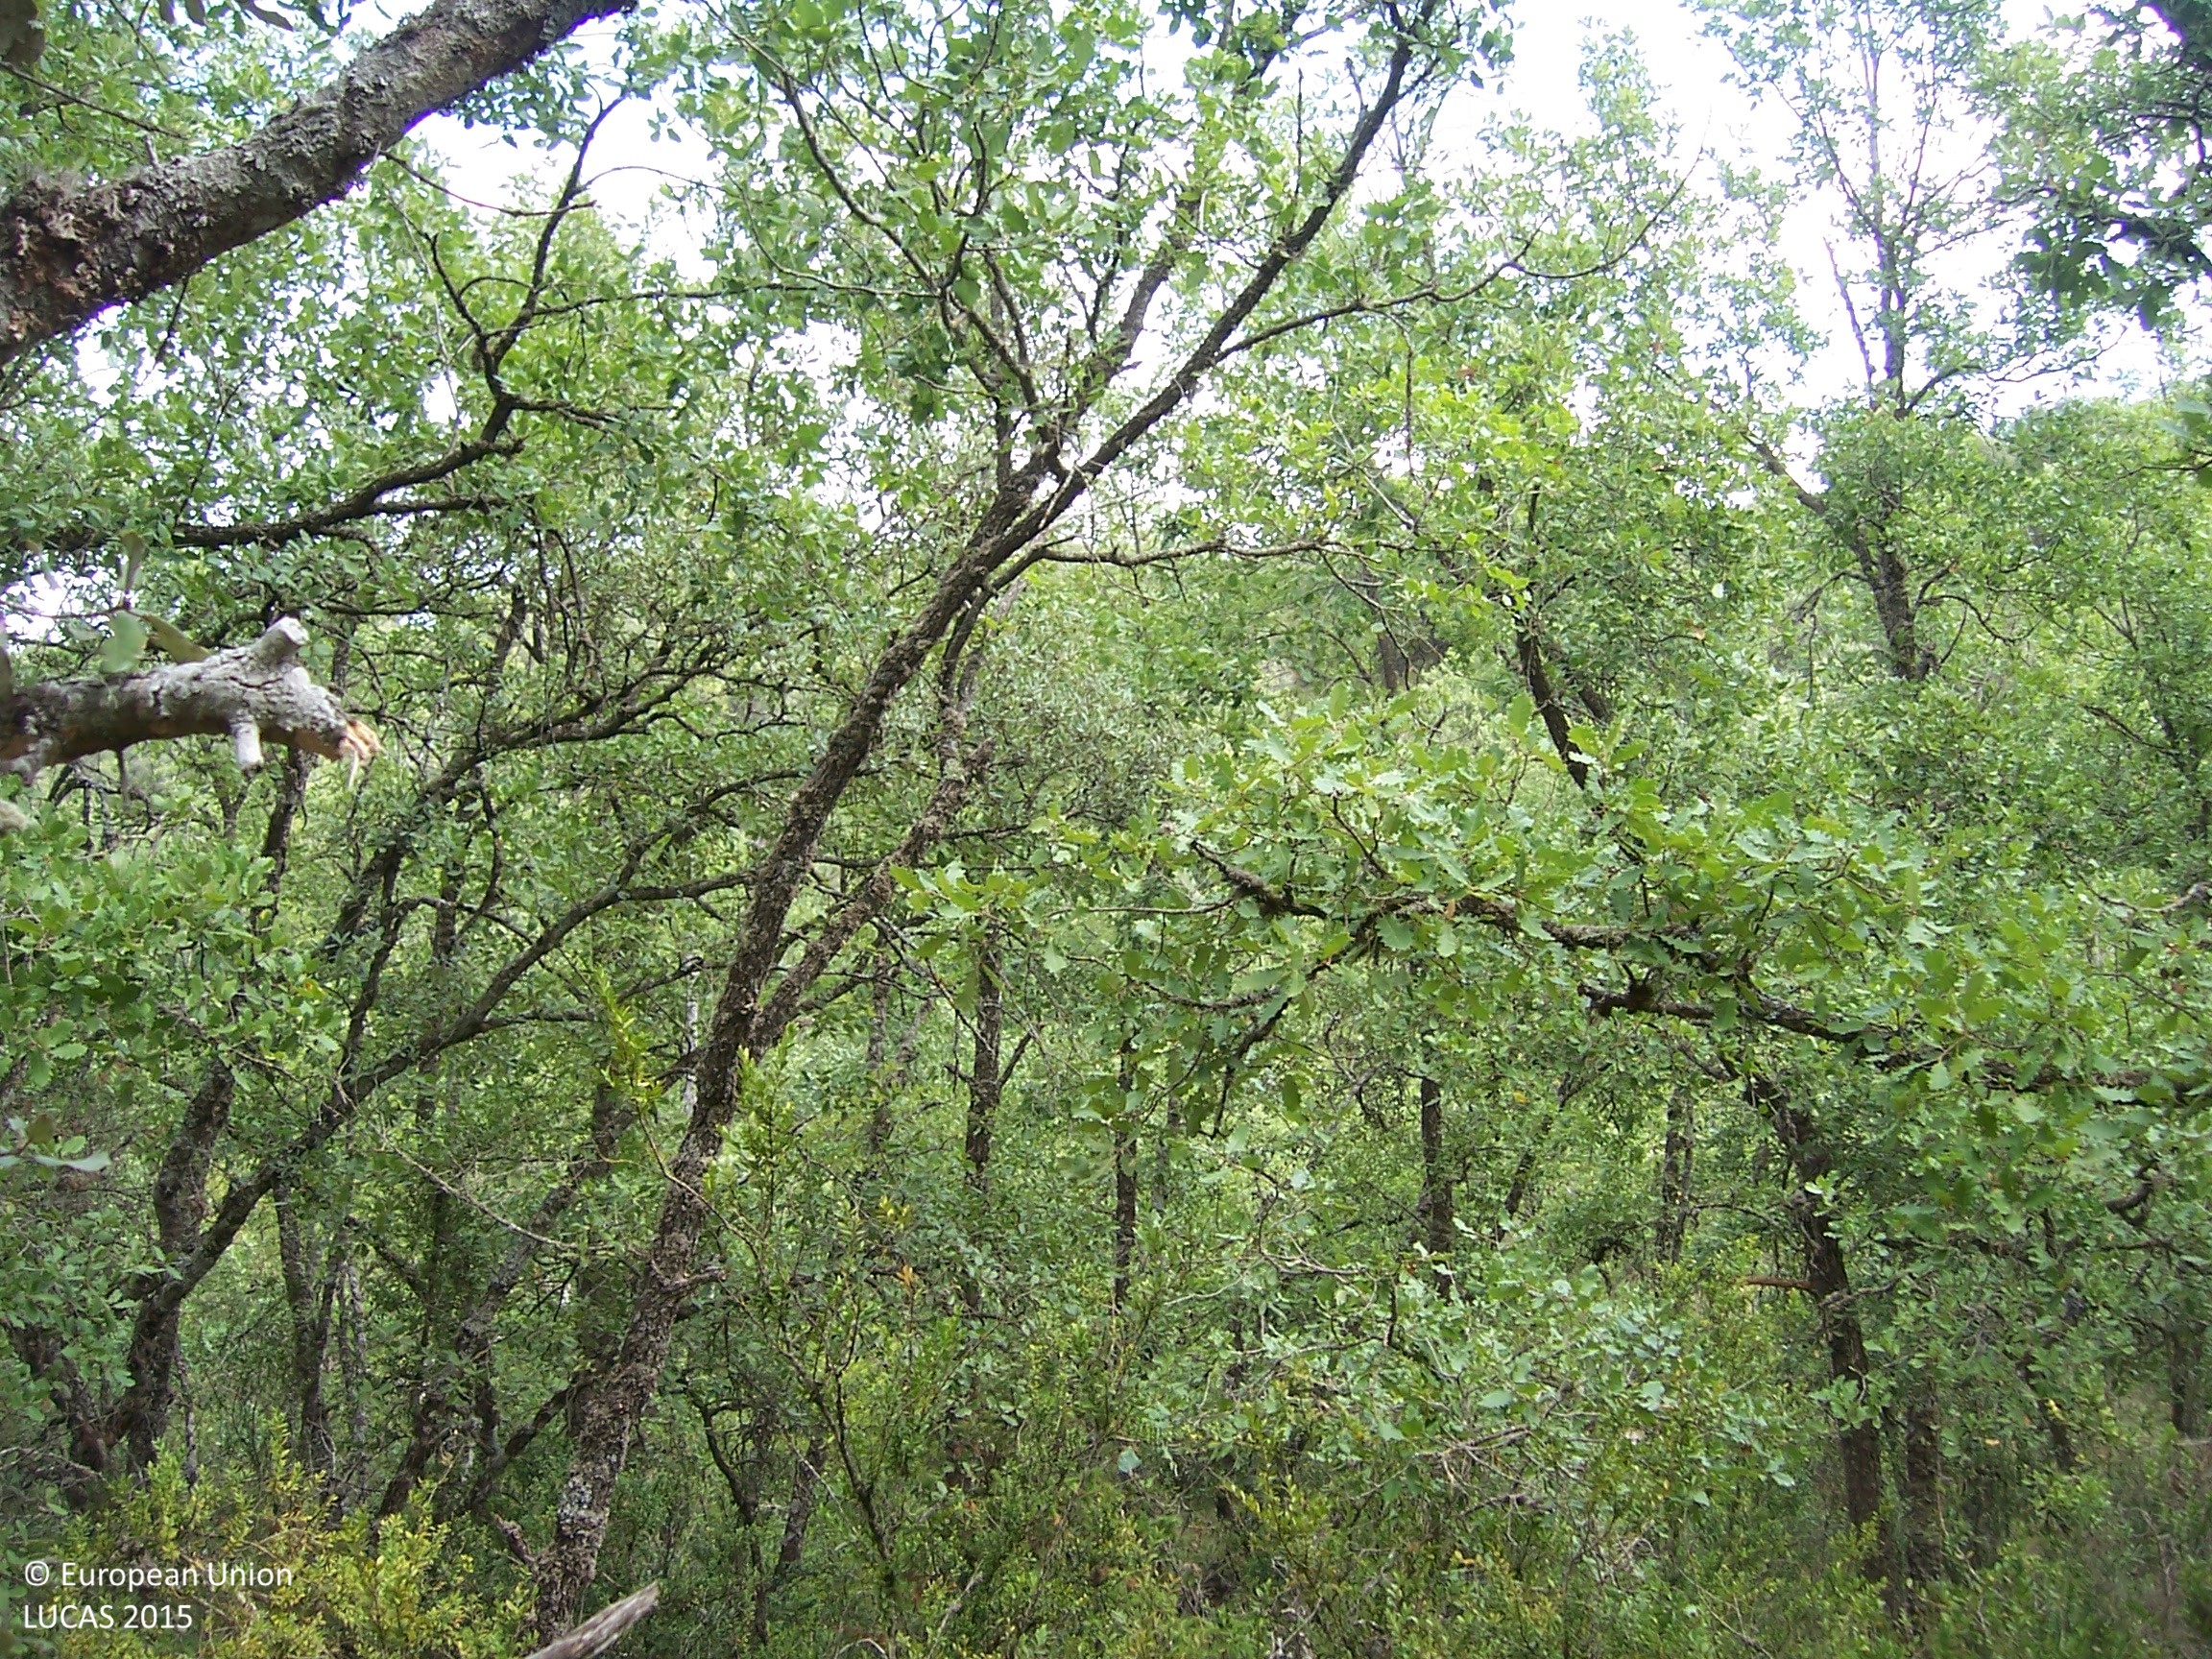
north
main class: Woodland
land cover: Broadleaved woodland
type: broadleaved evergreen forest
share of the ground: > 75 %
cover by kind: broadleaved forest trees 80 %, shrubs 10 %, herbaceous plants 10 %
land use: Semi-natural and natural areas not in use
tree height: > 5 m
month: August
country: ES
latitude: 42.0587
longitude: 0.4735
